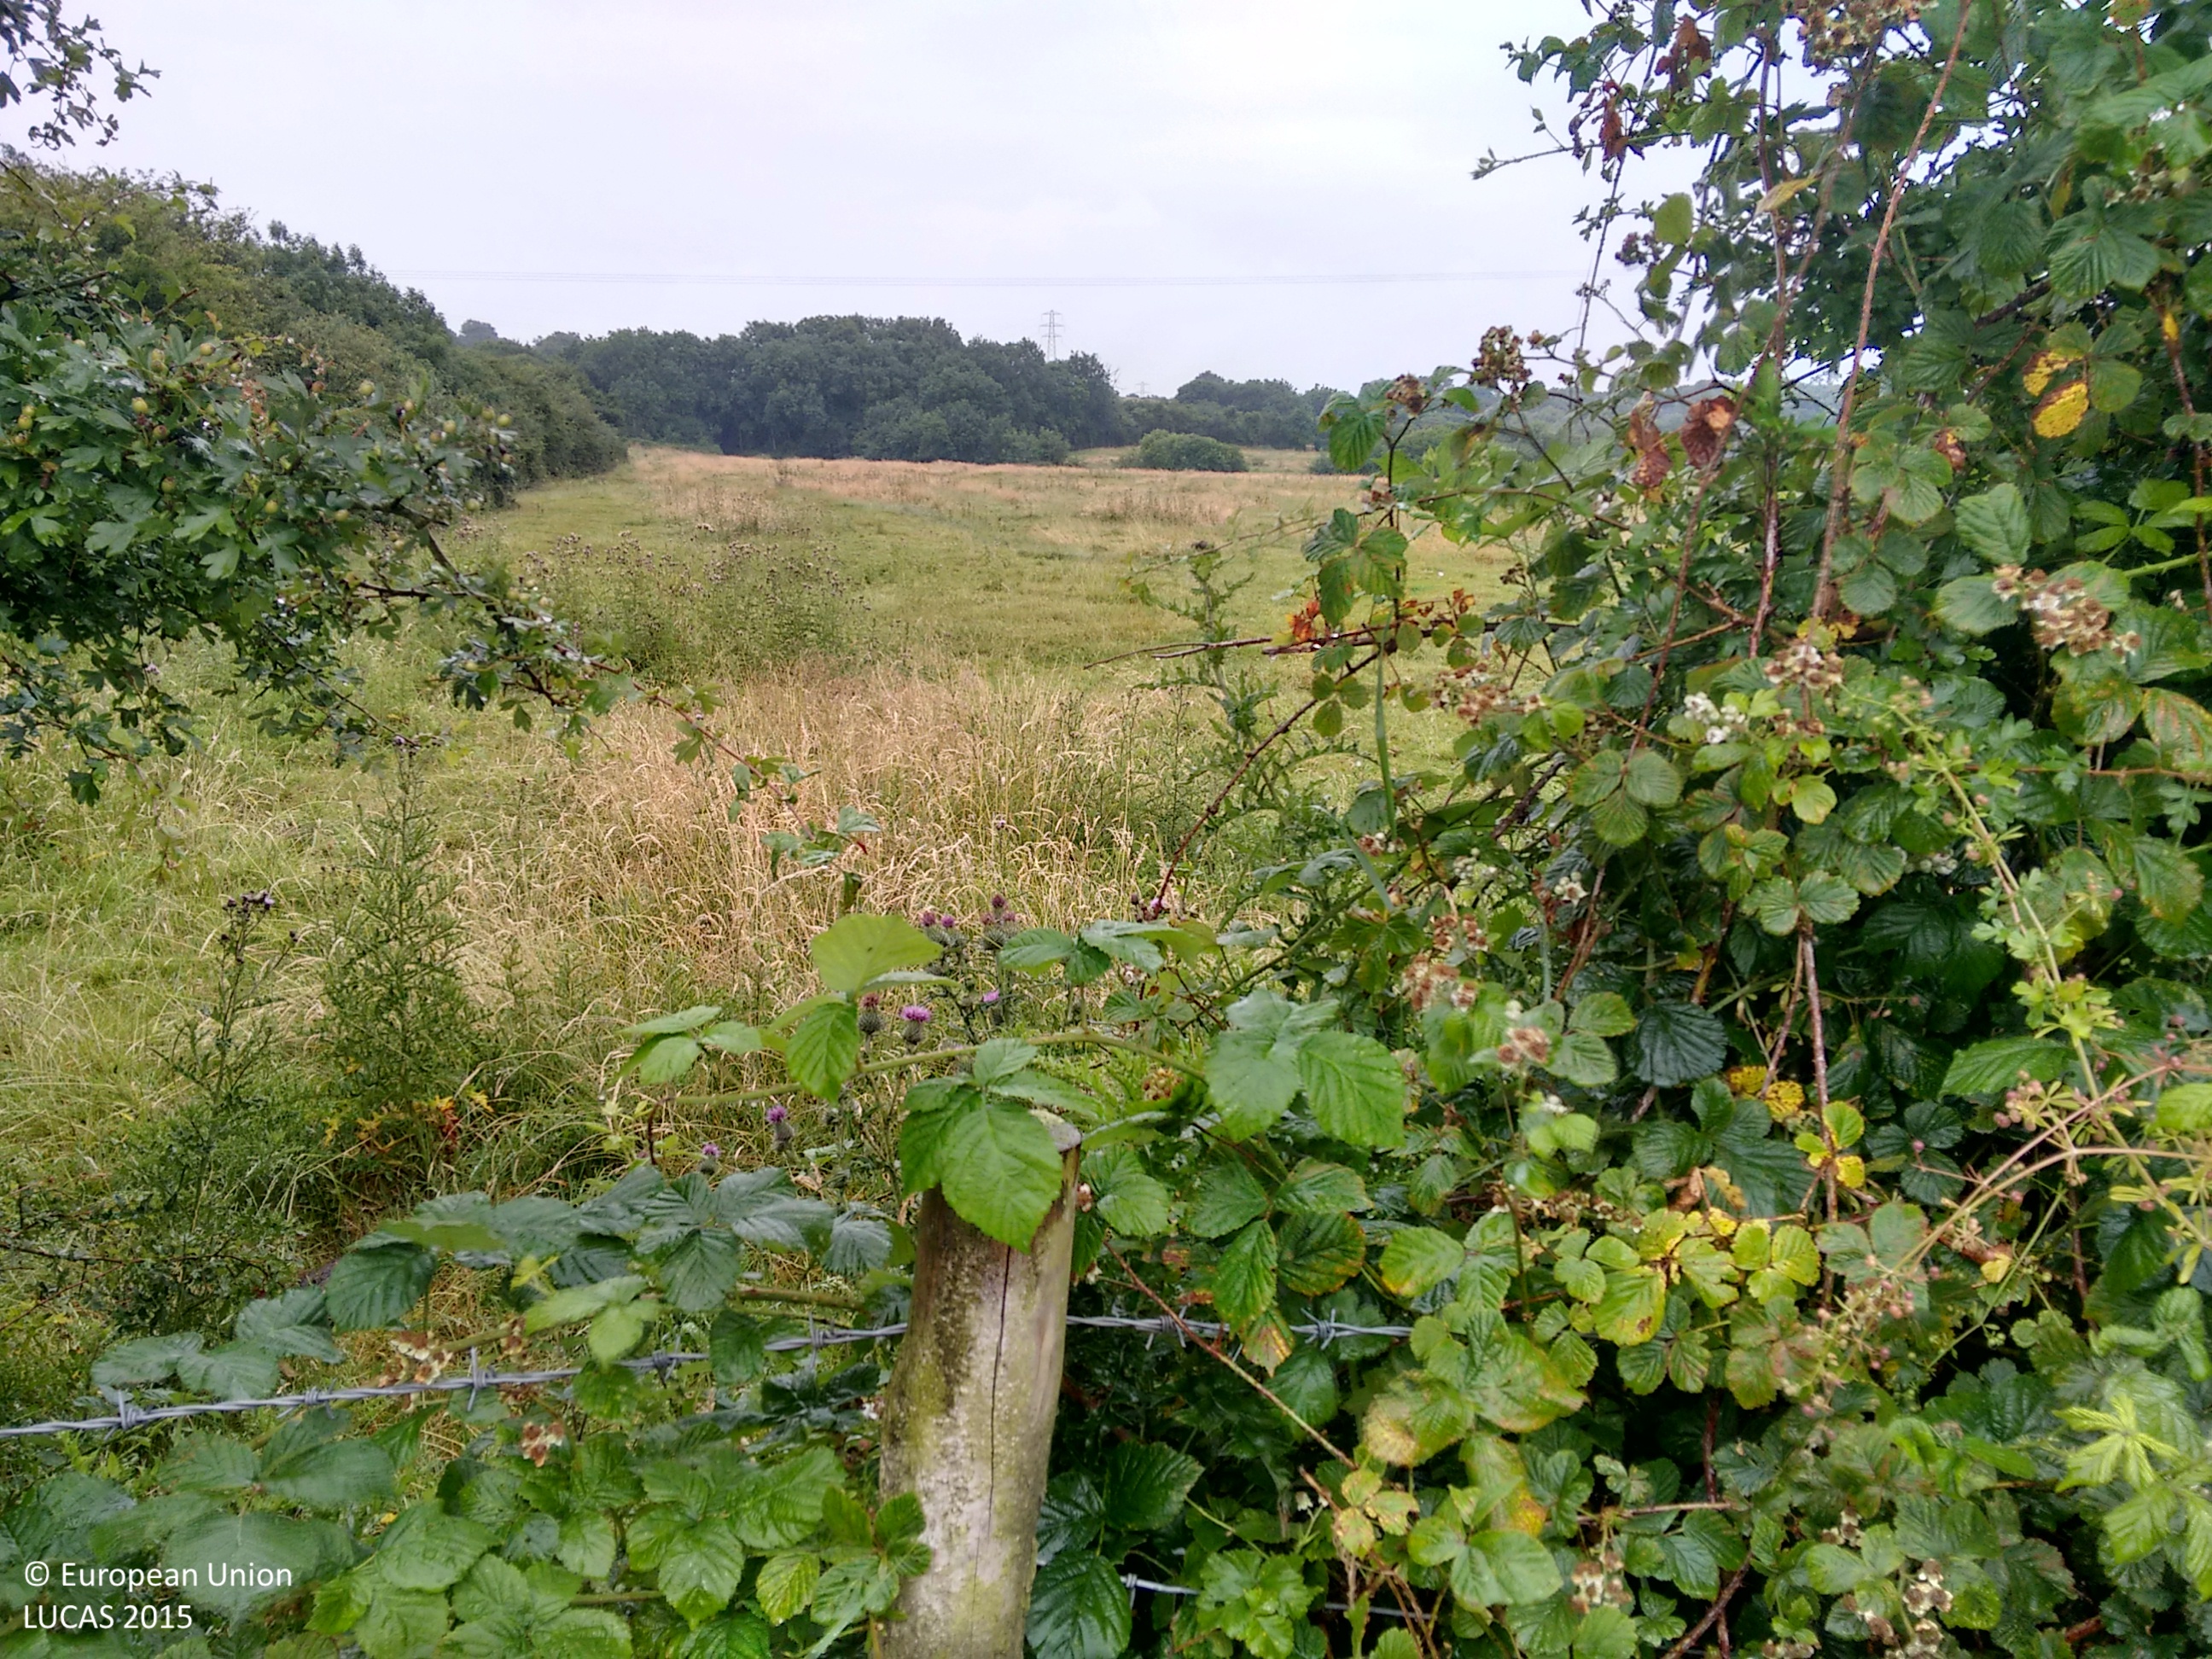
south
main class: Grassland
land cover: Grassland without tree/shrub cover
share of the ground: > 75 %
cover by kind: herbaceous plants 100 %
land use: Agriculture (excluding fallow land and kitchen gardens)
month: July
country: GB
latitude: 52.8363
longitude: -0.8939
